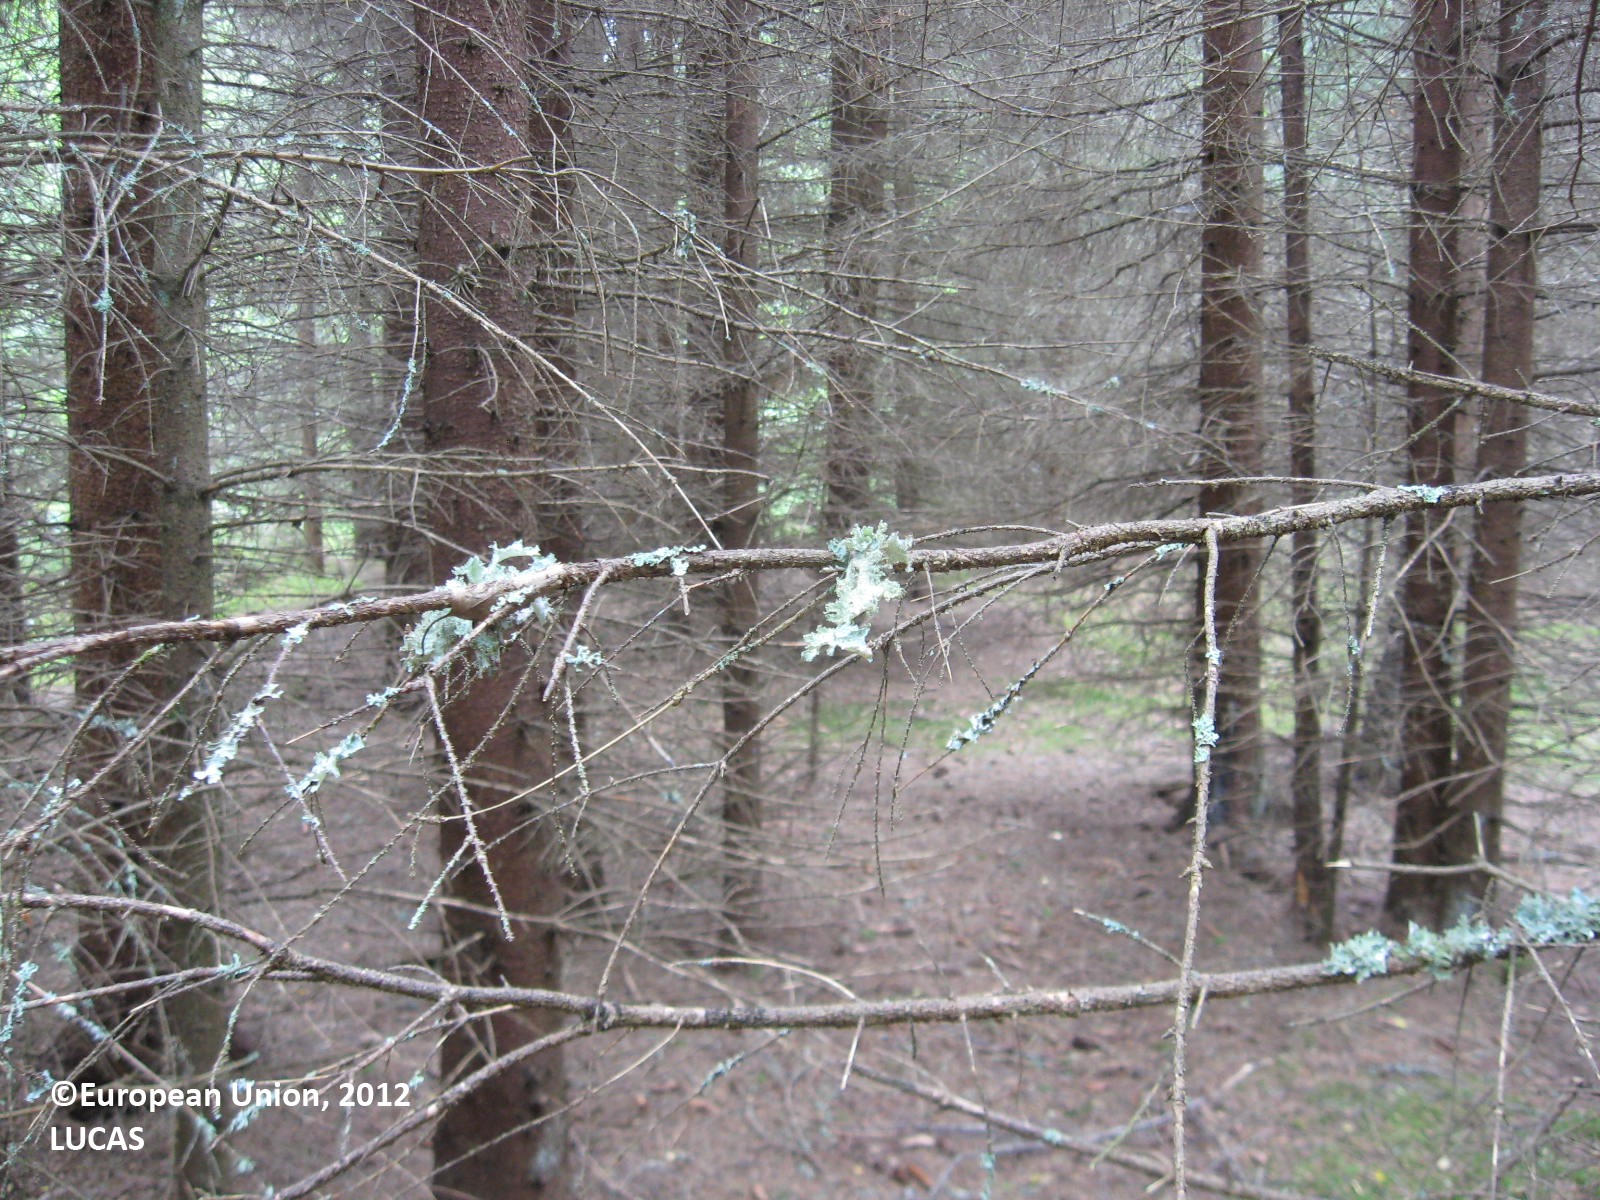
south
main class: Woodland
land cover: Spruce dominated coniferous woodland
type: boreal forest
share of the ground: > 75 %
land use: Forestry
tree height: > 5 m
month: July
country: FI
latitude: 62.0335
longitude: 21.3805
